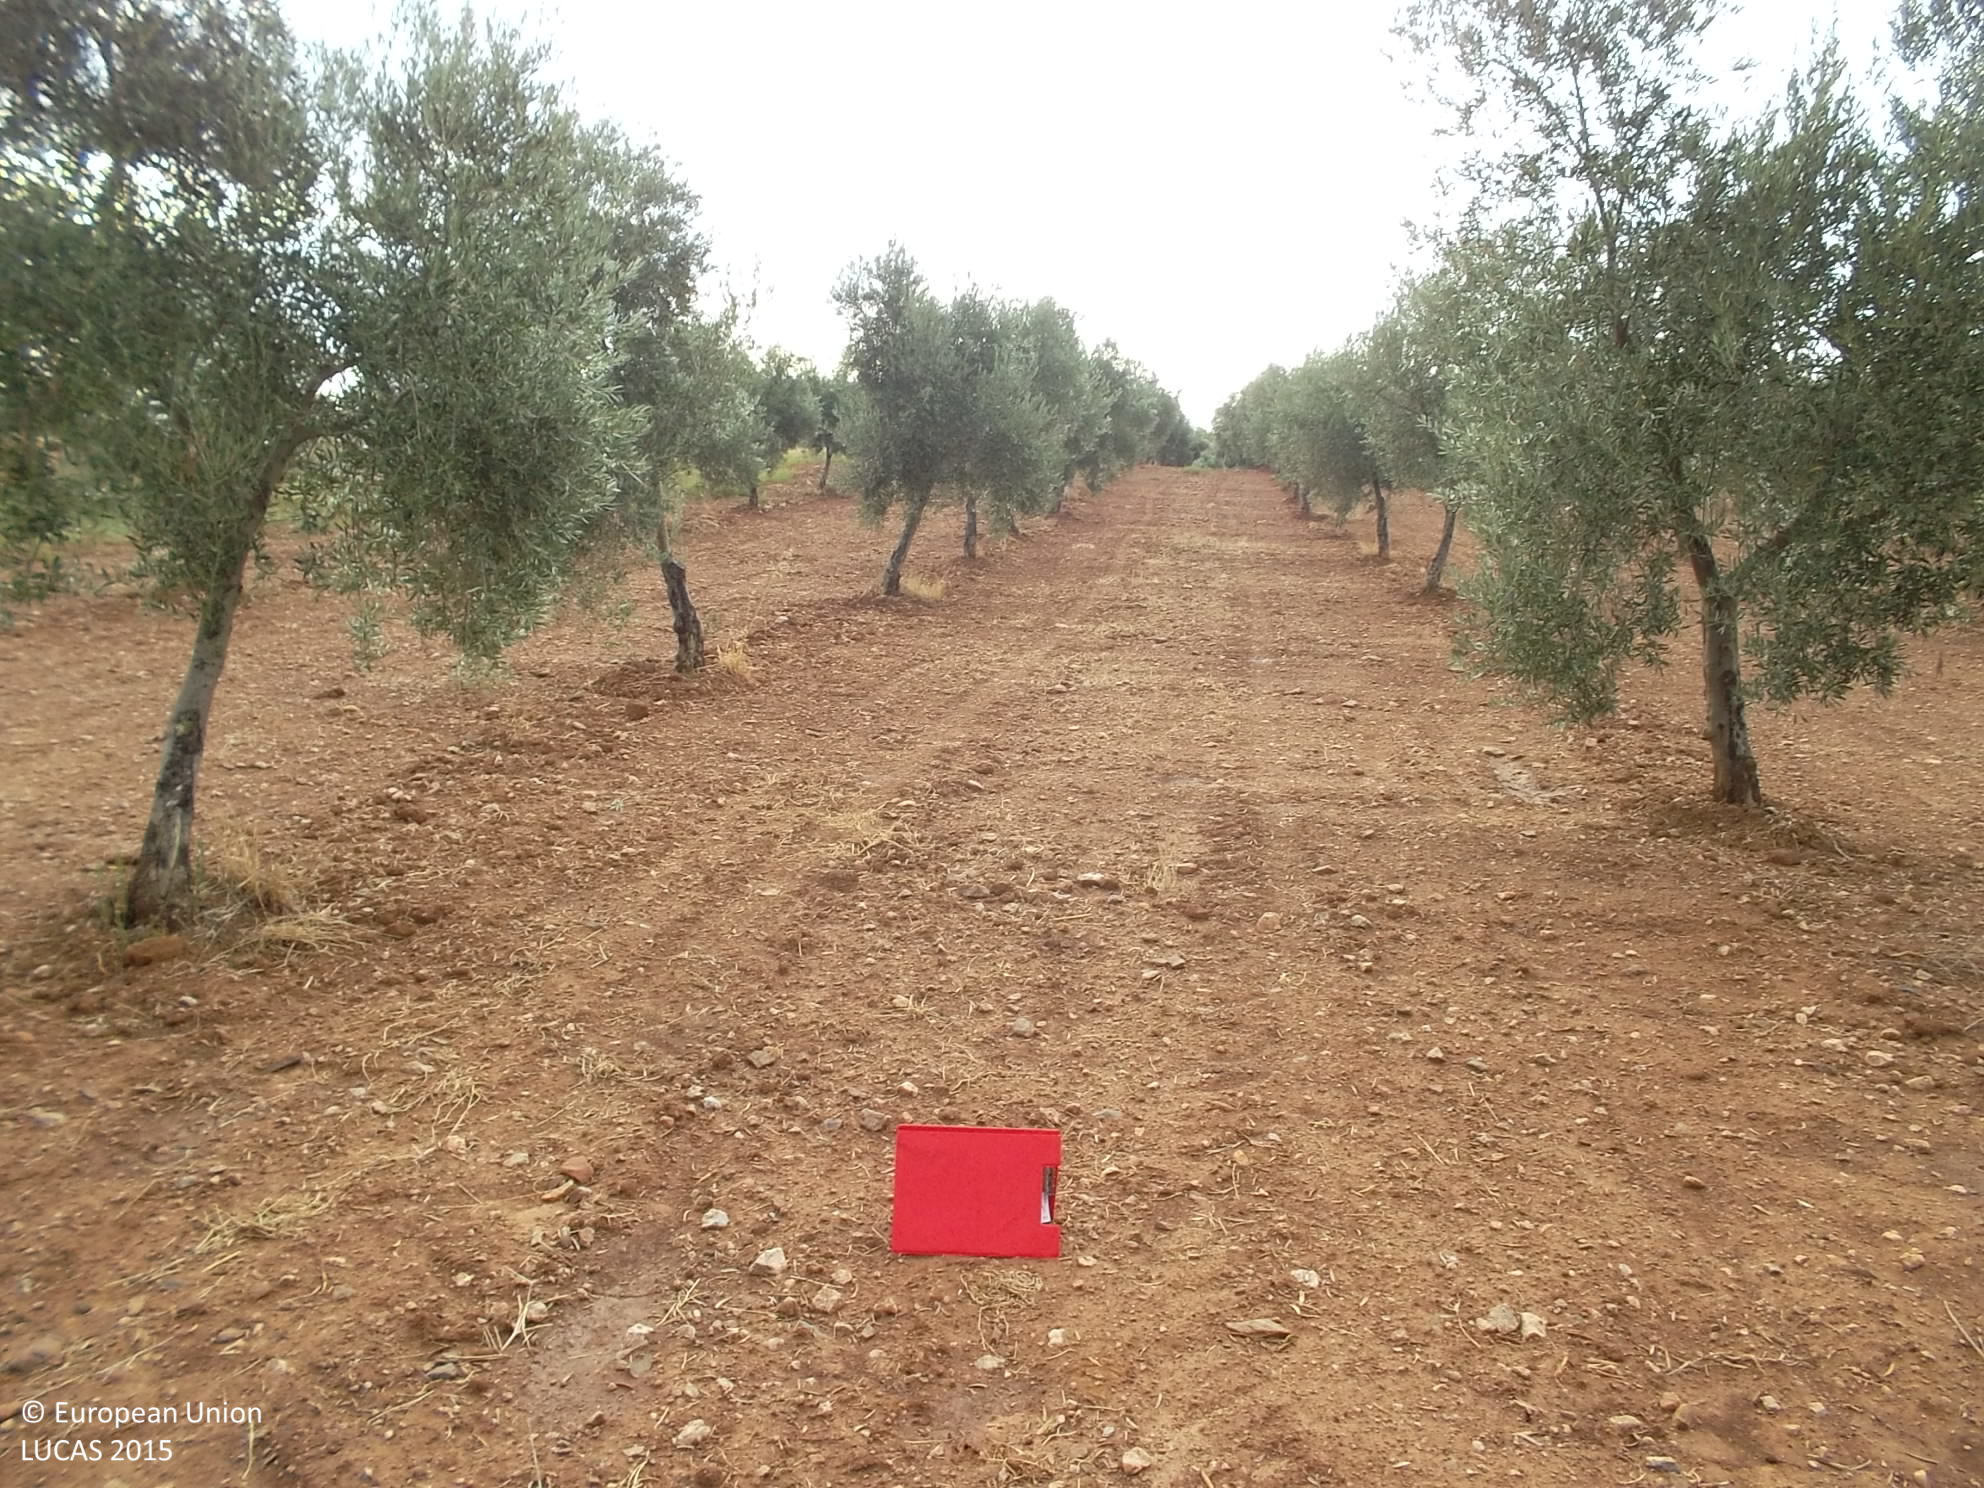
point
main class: Cropland
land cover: Olive groves
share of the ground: 50 - 75 %
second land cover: Other bare soil
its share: > 75 %
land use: Agriculture (excluding fallow land and kitchen gardens)
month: July
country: ES
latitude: 38.5861
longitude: -5.3838
